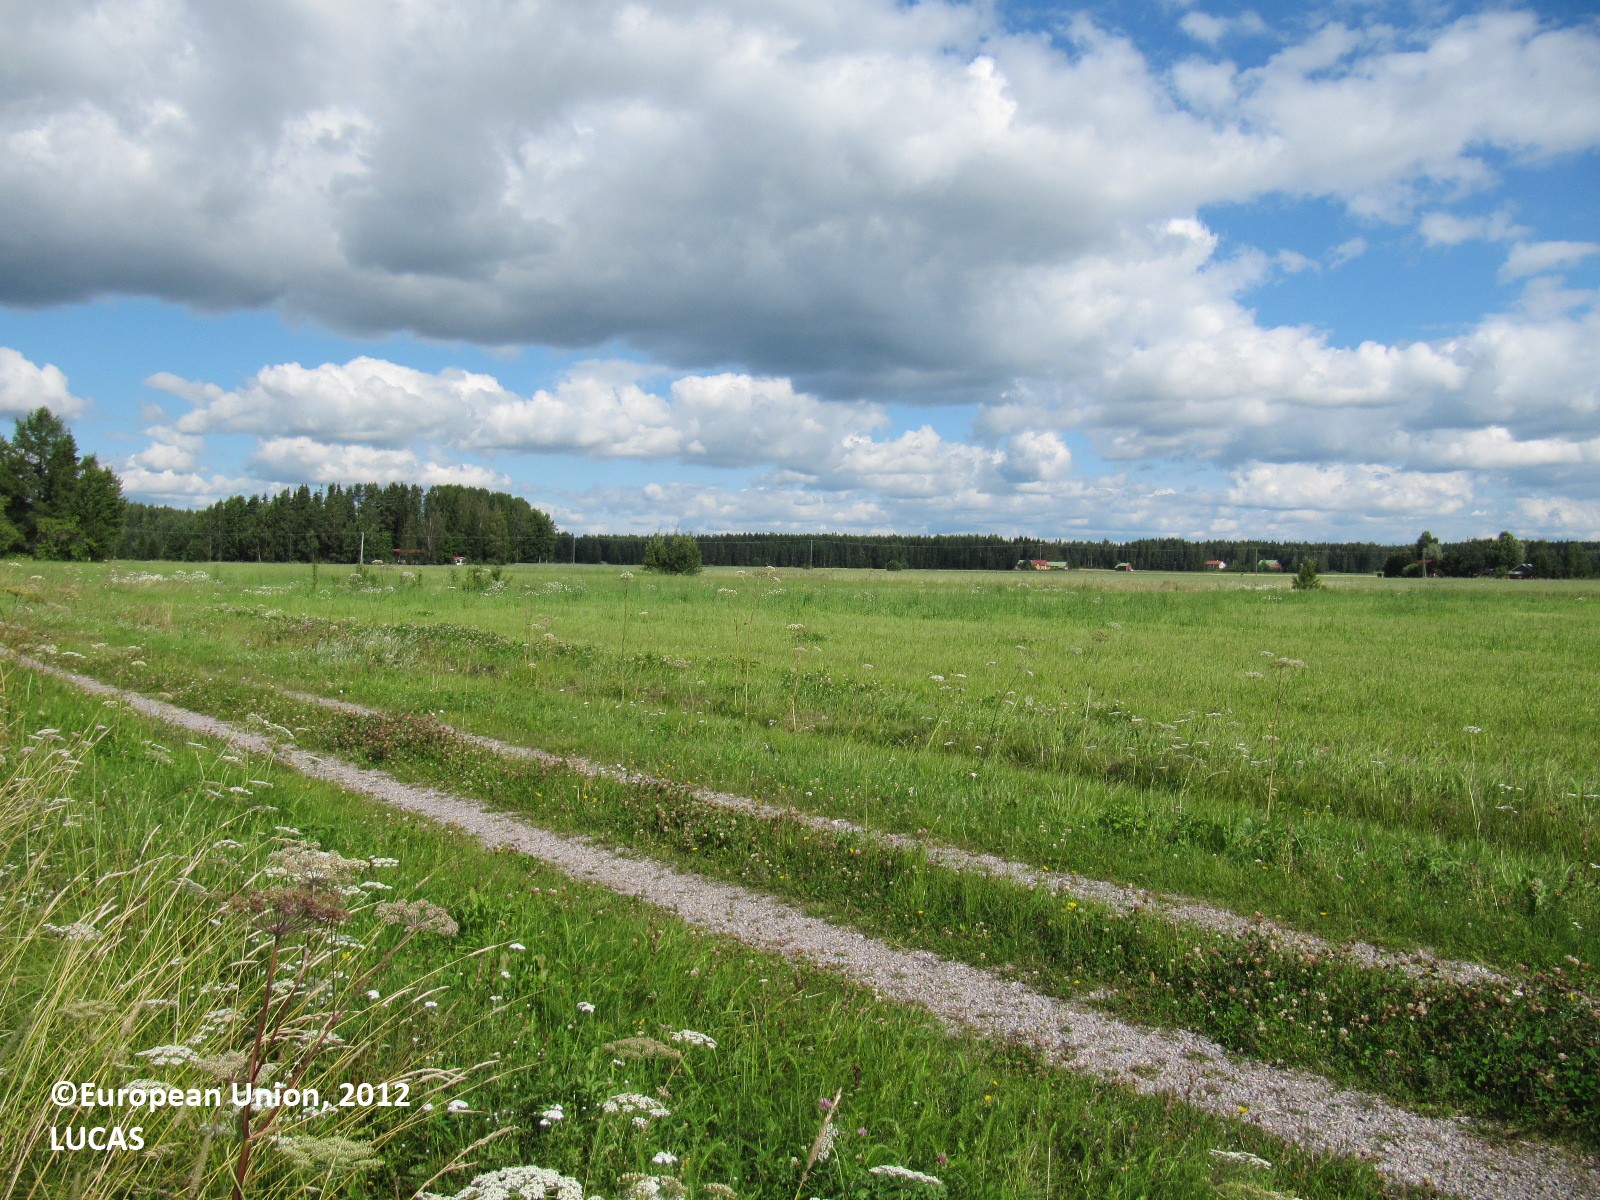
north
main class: Cropland
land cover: Barley
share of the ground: > 75 %
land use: Agriculture (excluding fallow land and kitchen gardens)
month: August
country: FI
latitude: 60.5632
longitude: 23.1962
